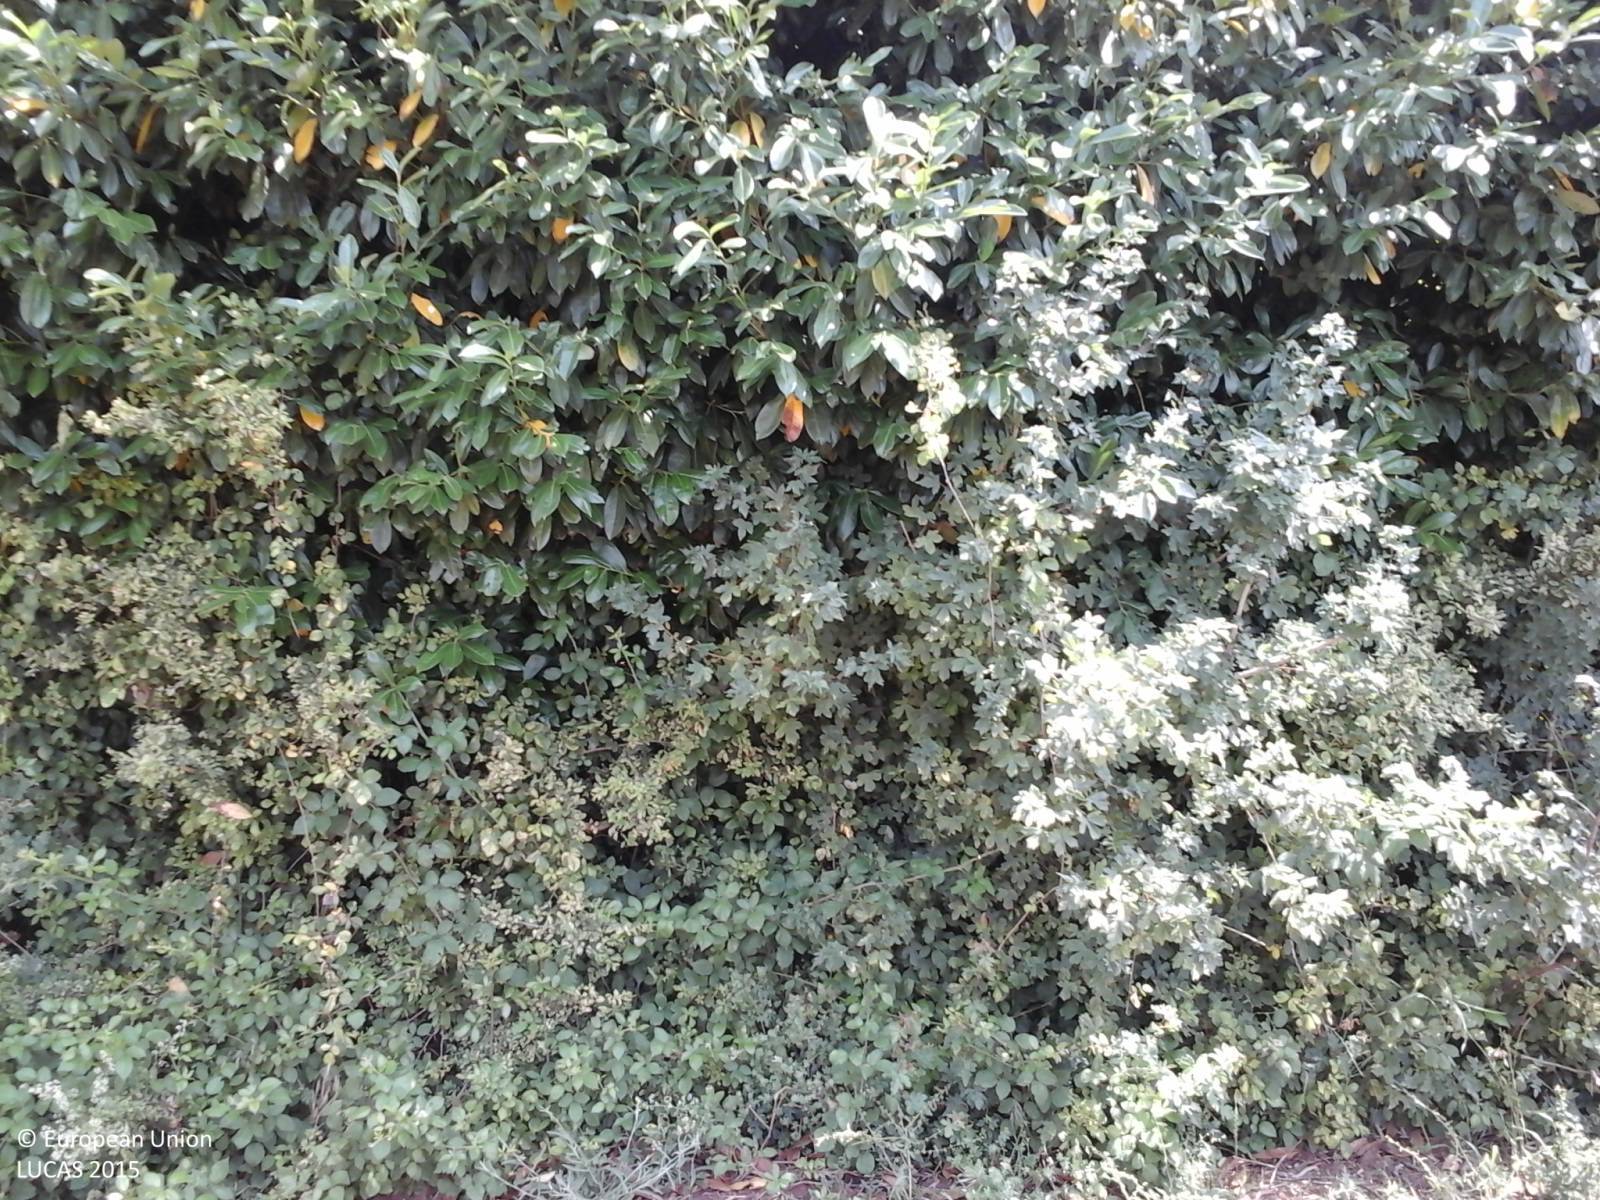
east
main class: Cropland
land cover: Maize
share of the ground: > 75 %
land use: Agriculture (excluding fallow land and kitchen gardens)
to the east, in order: Maize; Ditches and canals; Maize; Nuts trees; Managed hedges; Electric lines; Grass margins; Abandoned hedges; Fences; Nuts trees; Broadleaved woodland
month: June
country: IT
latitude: 42.4480
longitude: 12.2660
